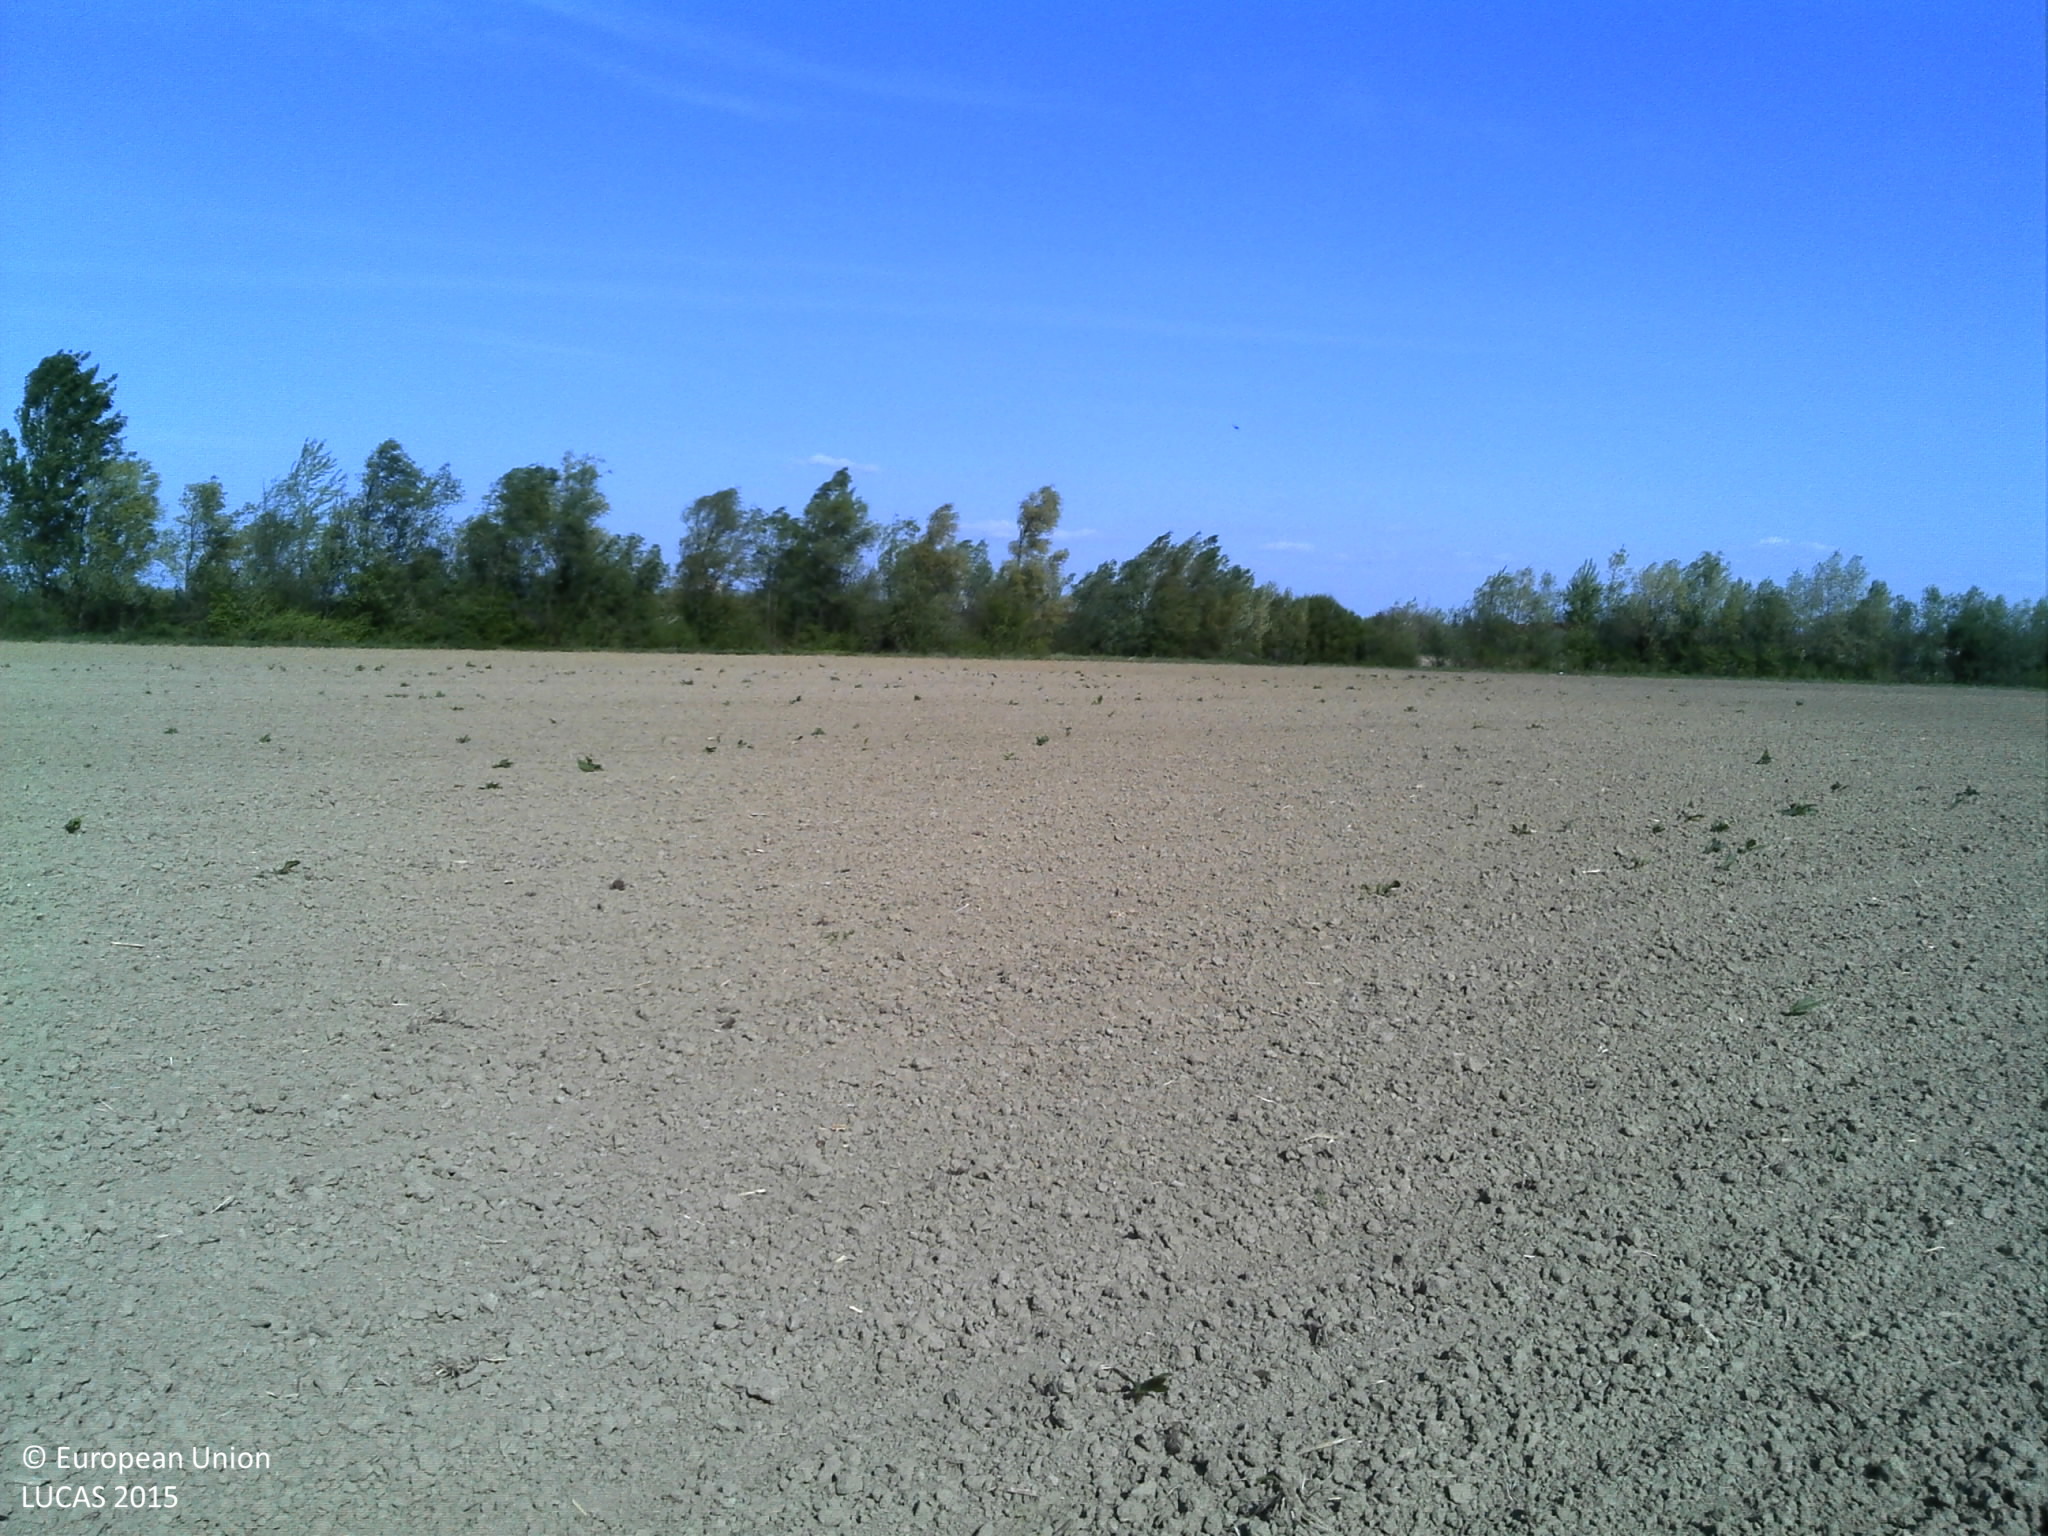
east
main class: Cropland
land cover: Soya
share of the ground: < 10 %
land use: Agriculture (excluding fallow land and kitchen gardens)
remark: Tilled/Sowed
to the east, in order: Soya; Ditches and canals; Shrubland with sparse tree cover; Other bare soil; Tracks; Ditches and canals; Shrubland with sparse tree cover; Other bare soil
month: April
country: HR
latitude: 44.9274
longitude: 18.9131
